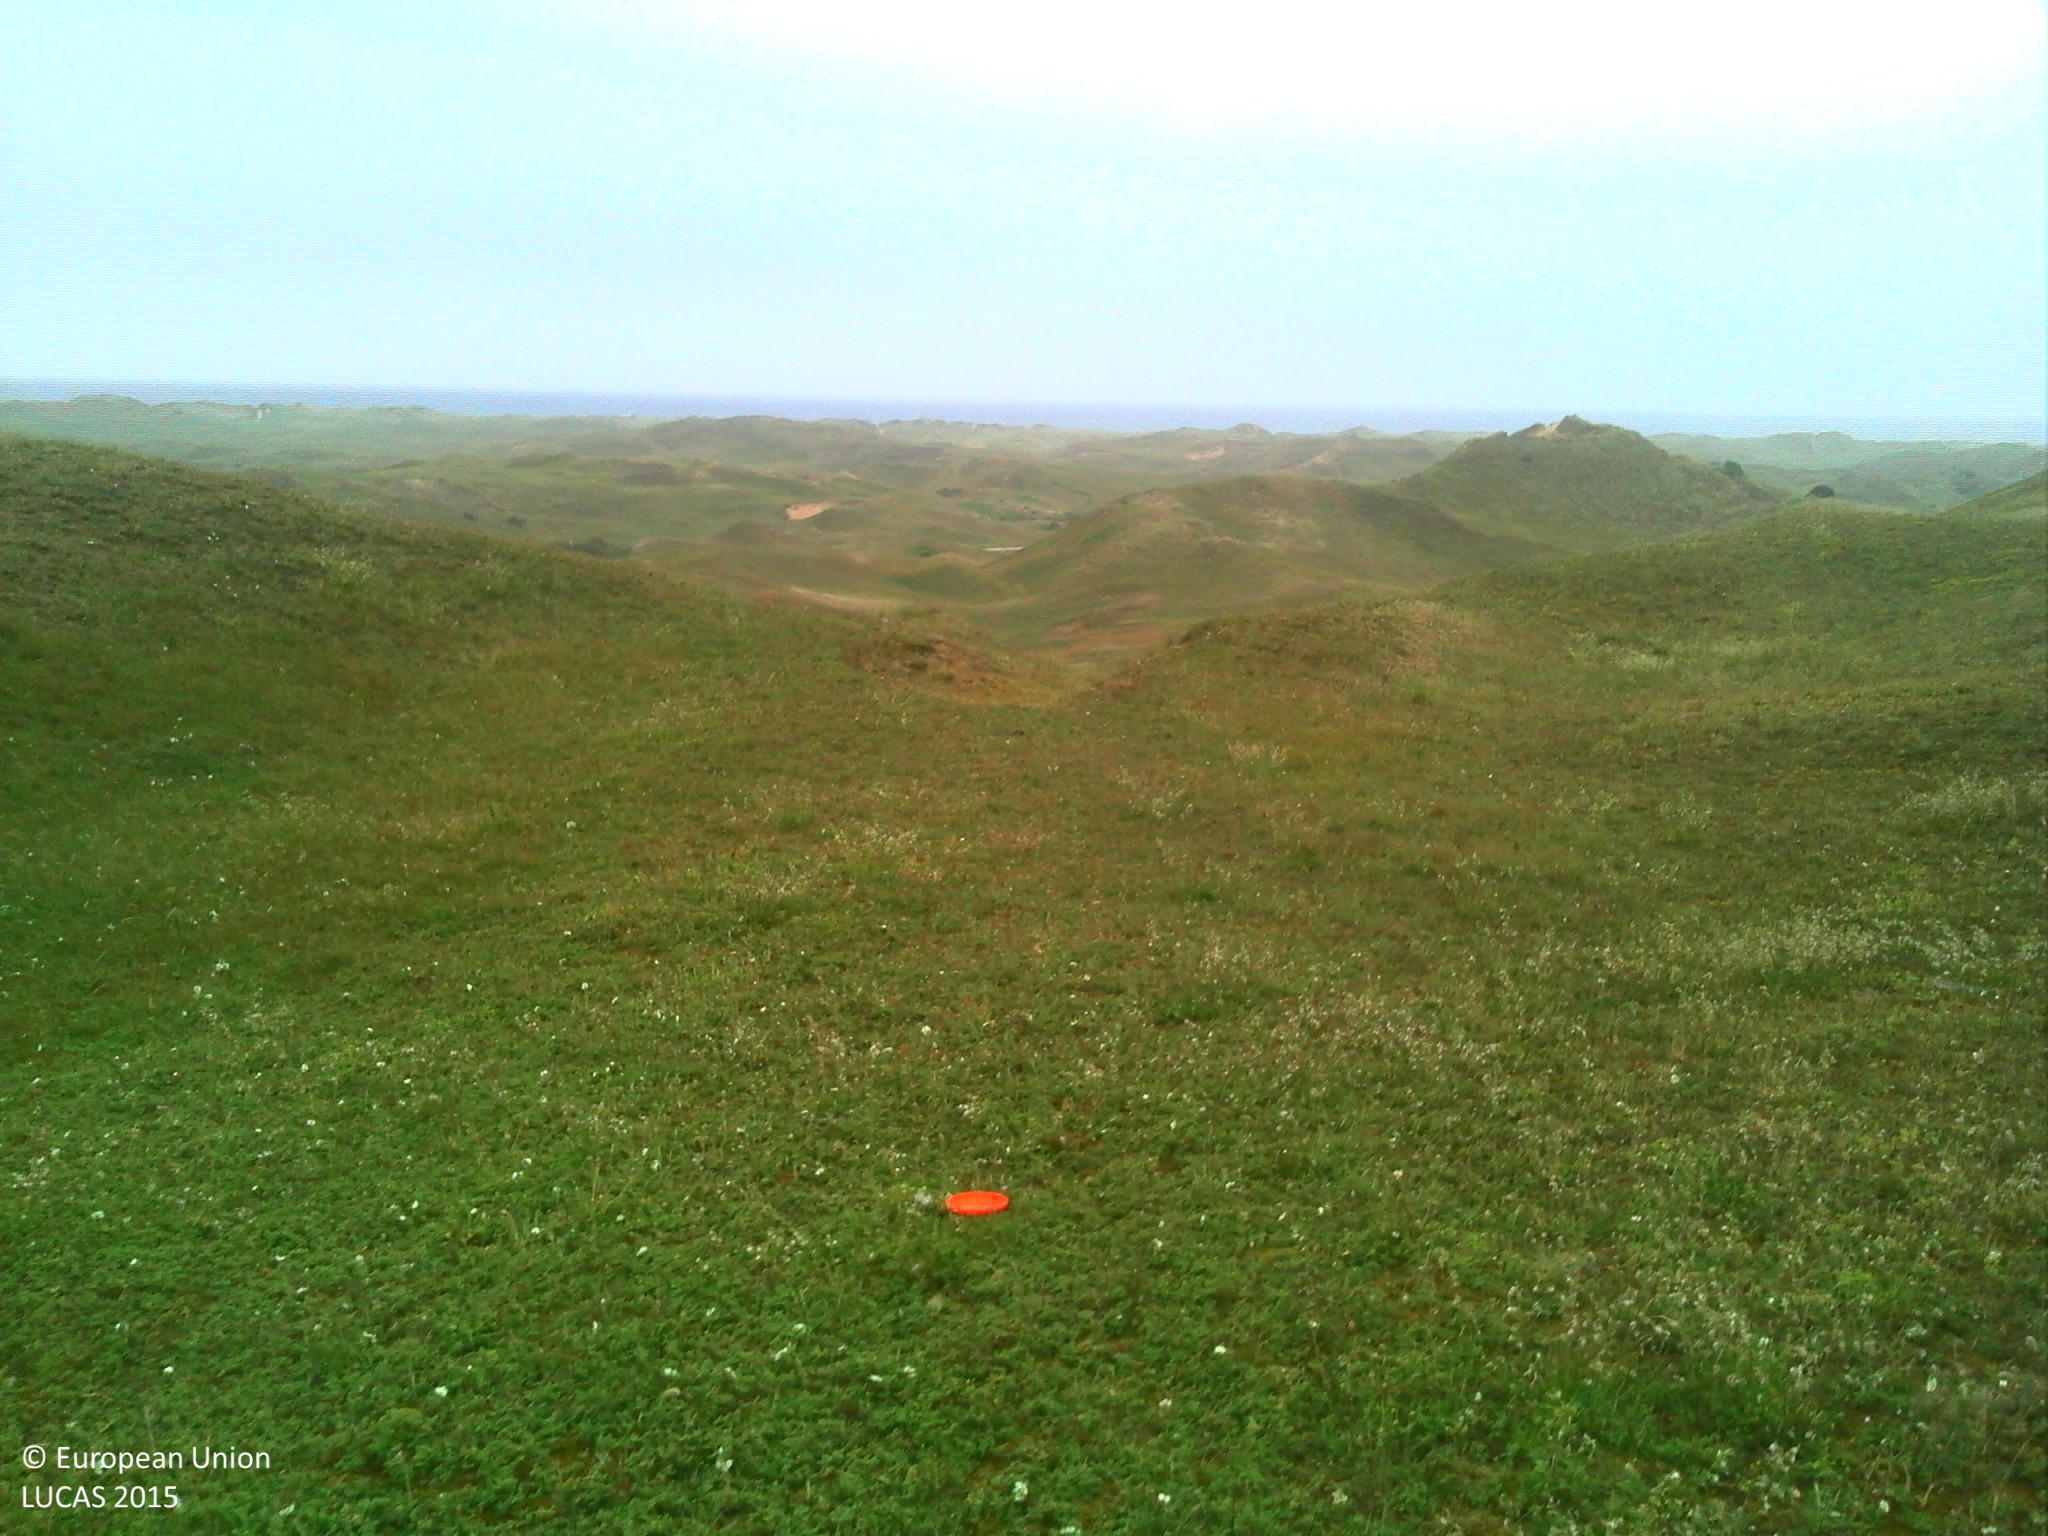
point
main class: Grassland
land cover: Spontaneously vegetated surfaces
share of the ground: > 75 %
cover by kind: herbaceous plants 100 %
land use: Semi-natural and natural areas not in use
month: June
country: FR
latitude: 49.6022
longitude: -1.8295
